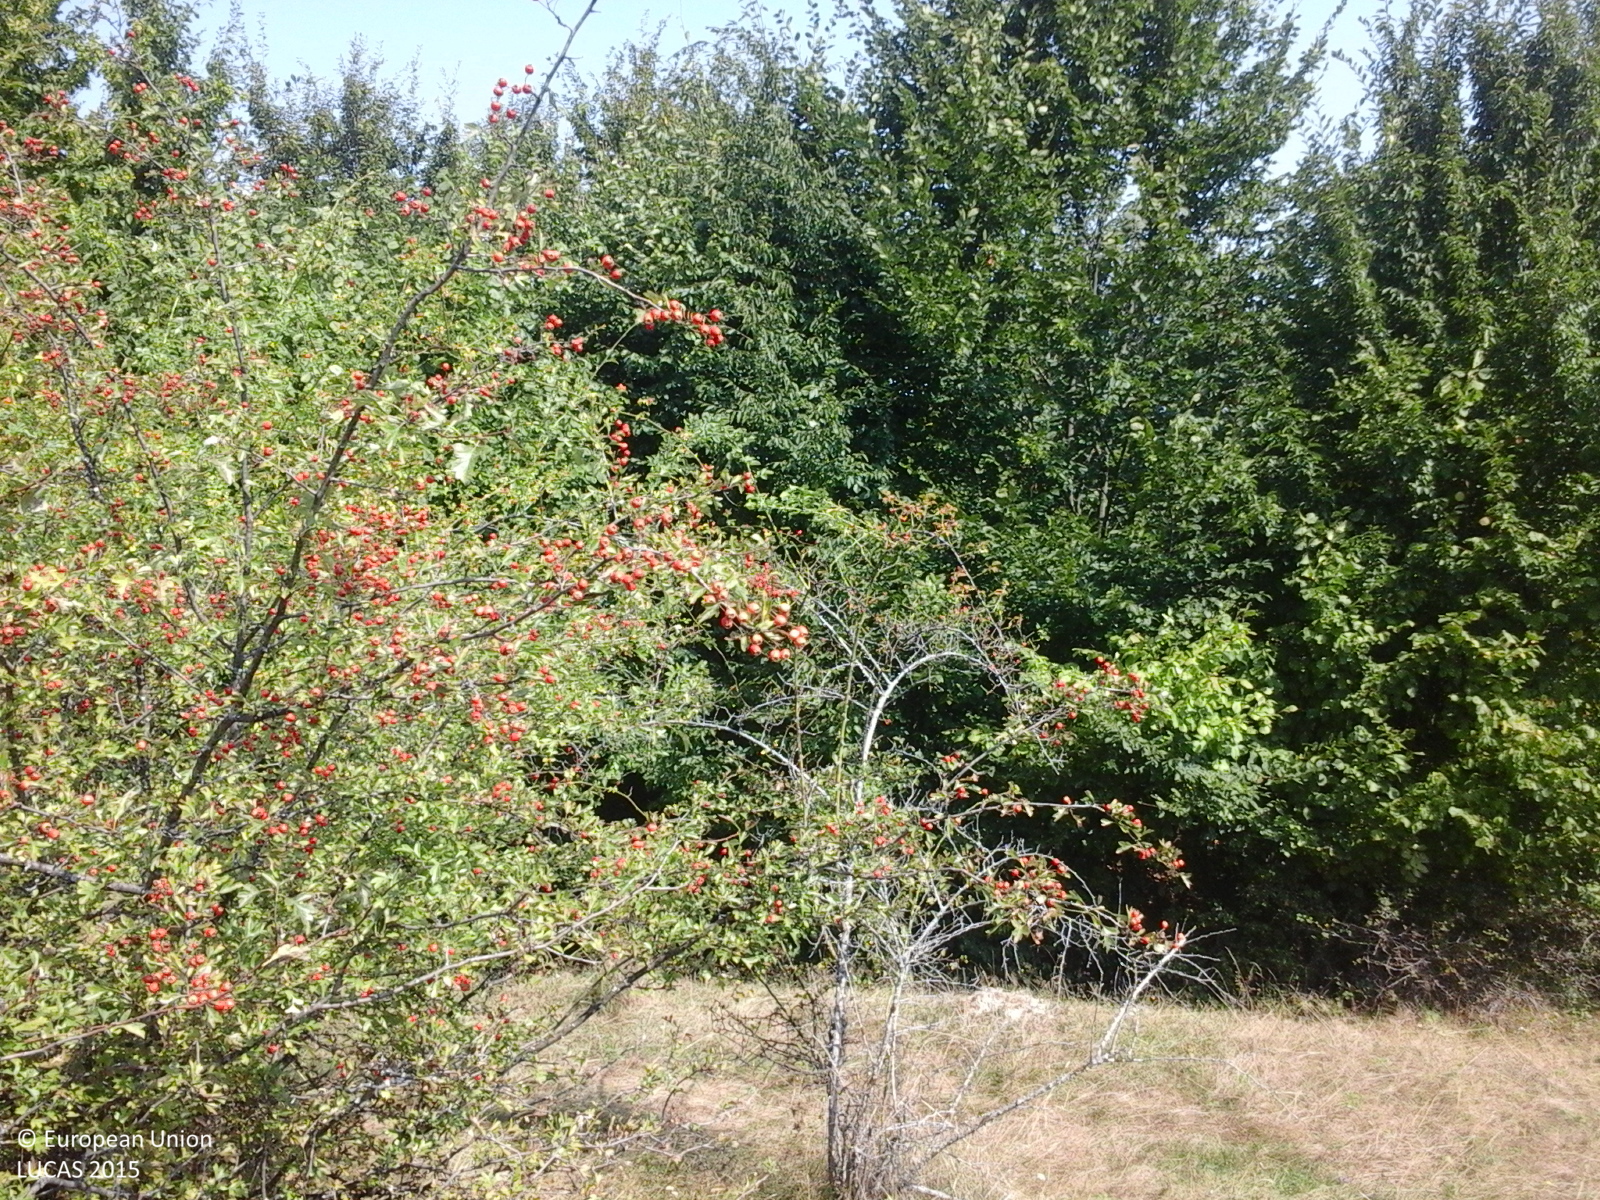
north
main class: Grassland
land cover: Grassland with sparse tree/shrub cover
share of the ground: > 75 %
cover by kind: herbaceous plants 85 %, shrubs 10 %, broadleaved forest trees 5 %
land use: Semi-natural and natural areas not in use
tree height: < 5 m
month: September
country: RO
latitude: 47.0657
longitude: 24.0252
